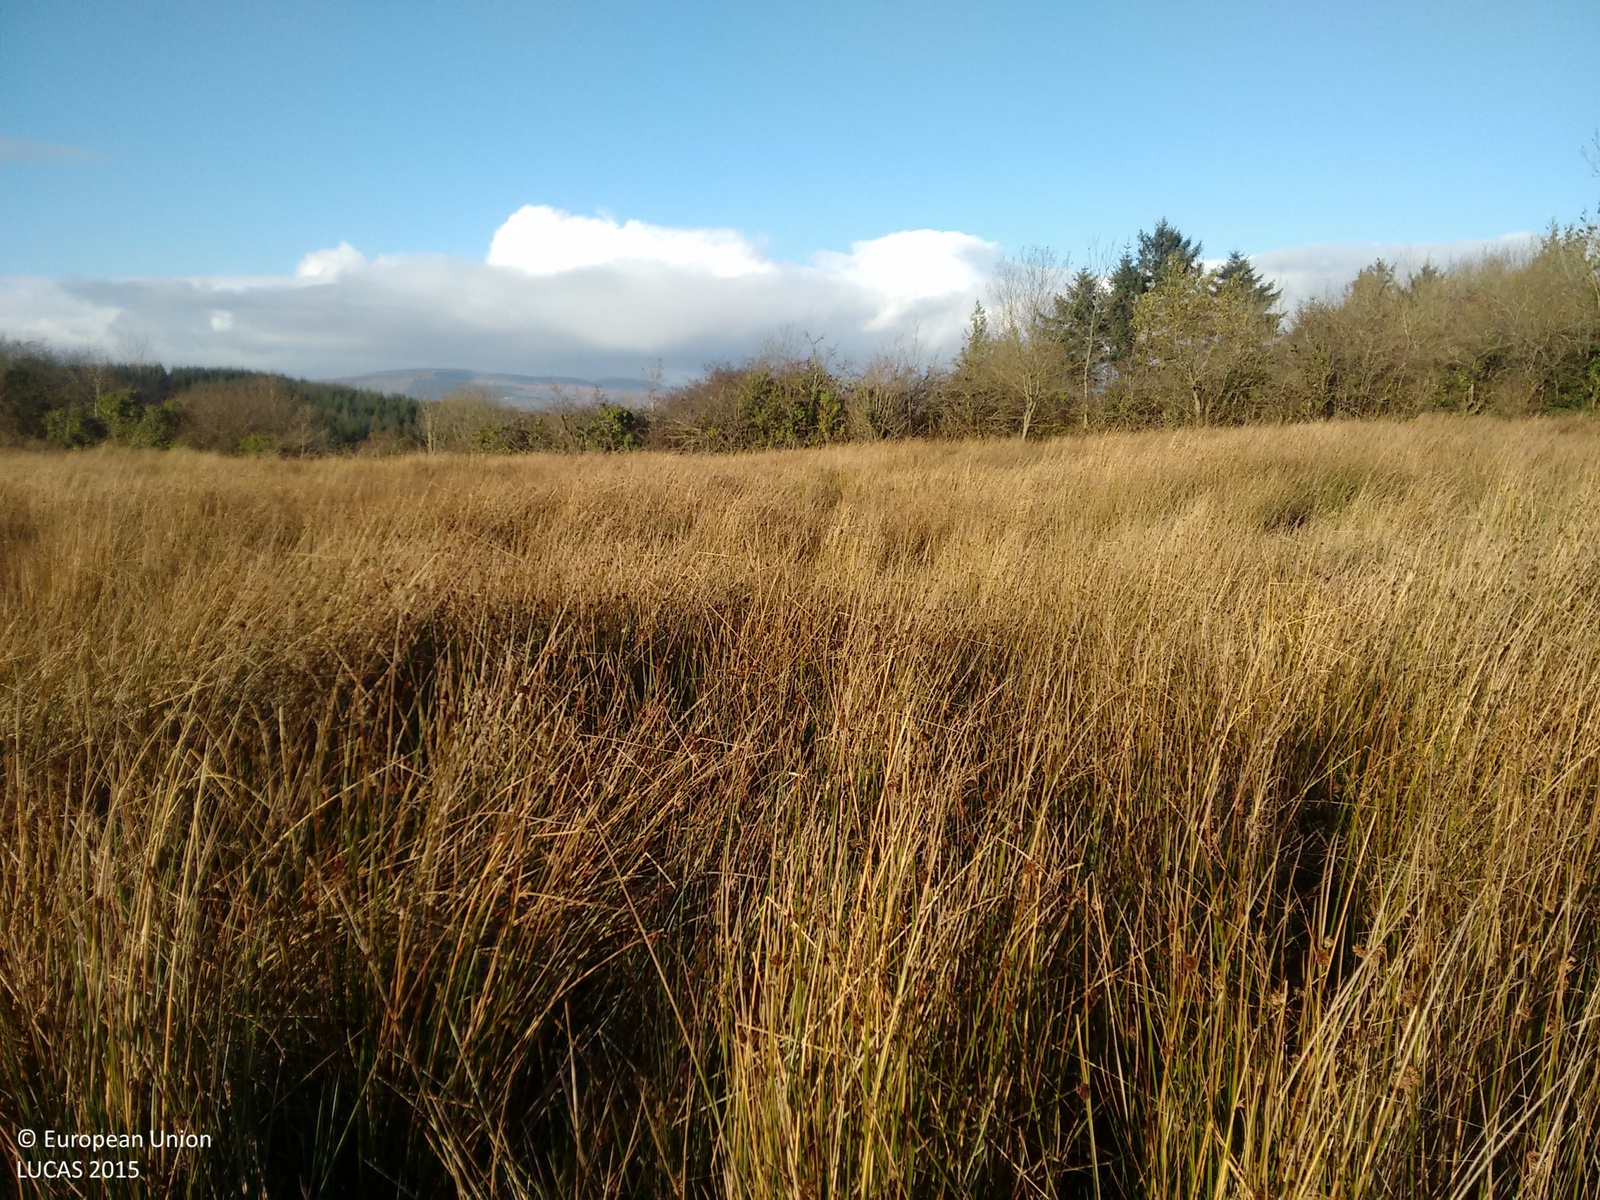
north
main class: Grassland
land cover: Grassland without tree/shrub cover
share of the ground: > 75 %
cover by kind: herbaceous plants 100 %
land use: Agriculture (excluding fallow land and kitchen gardens)
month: November
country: IE
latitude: 53.9752
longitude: -7.8710
